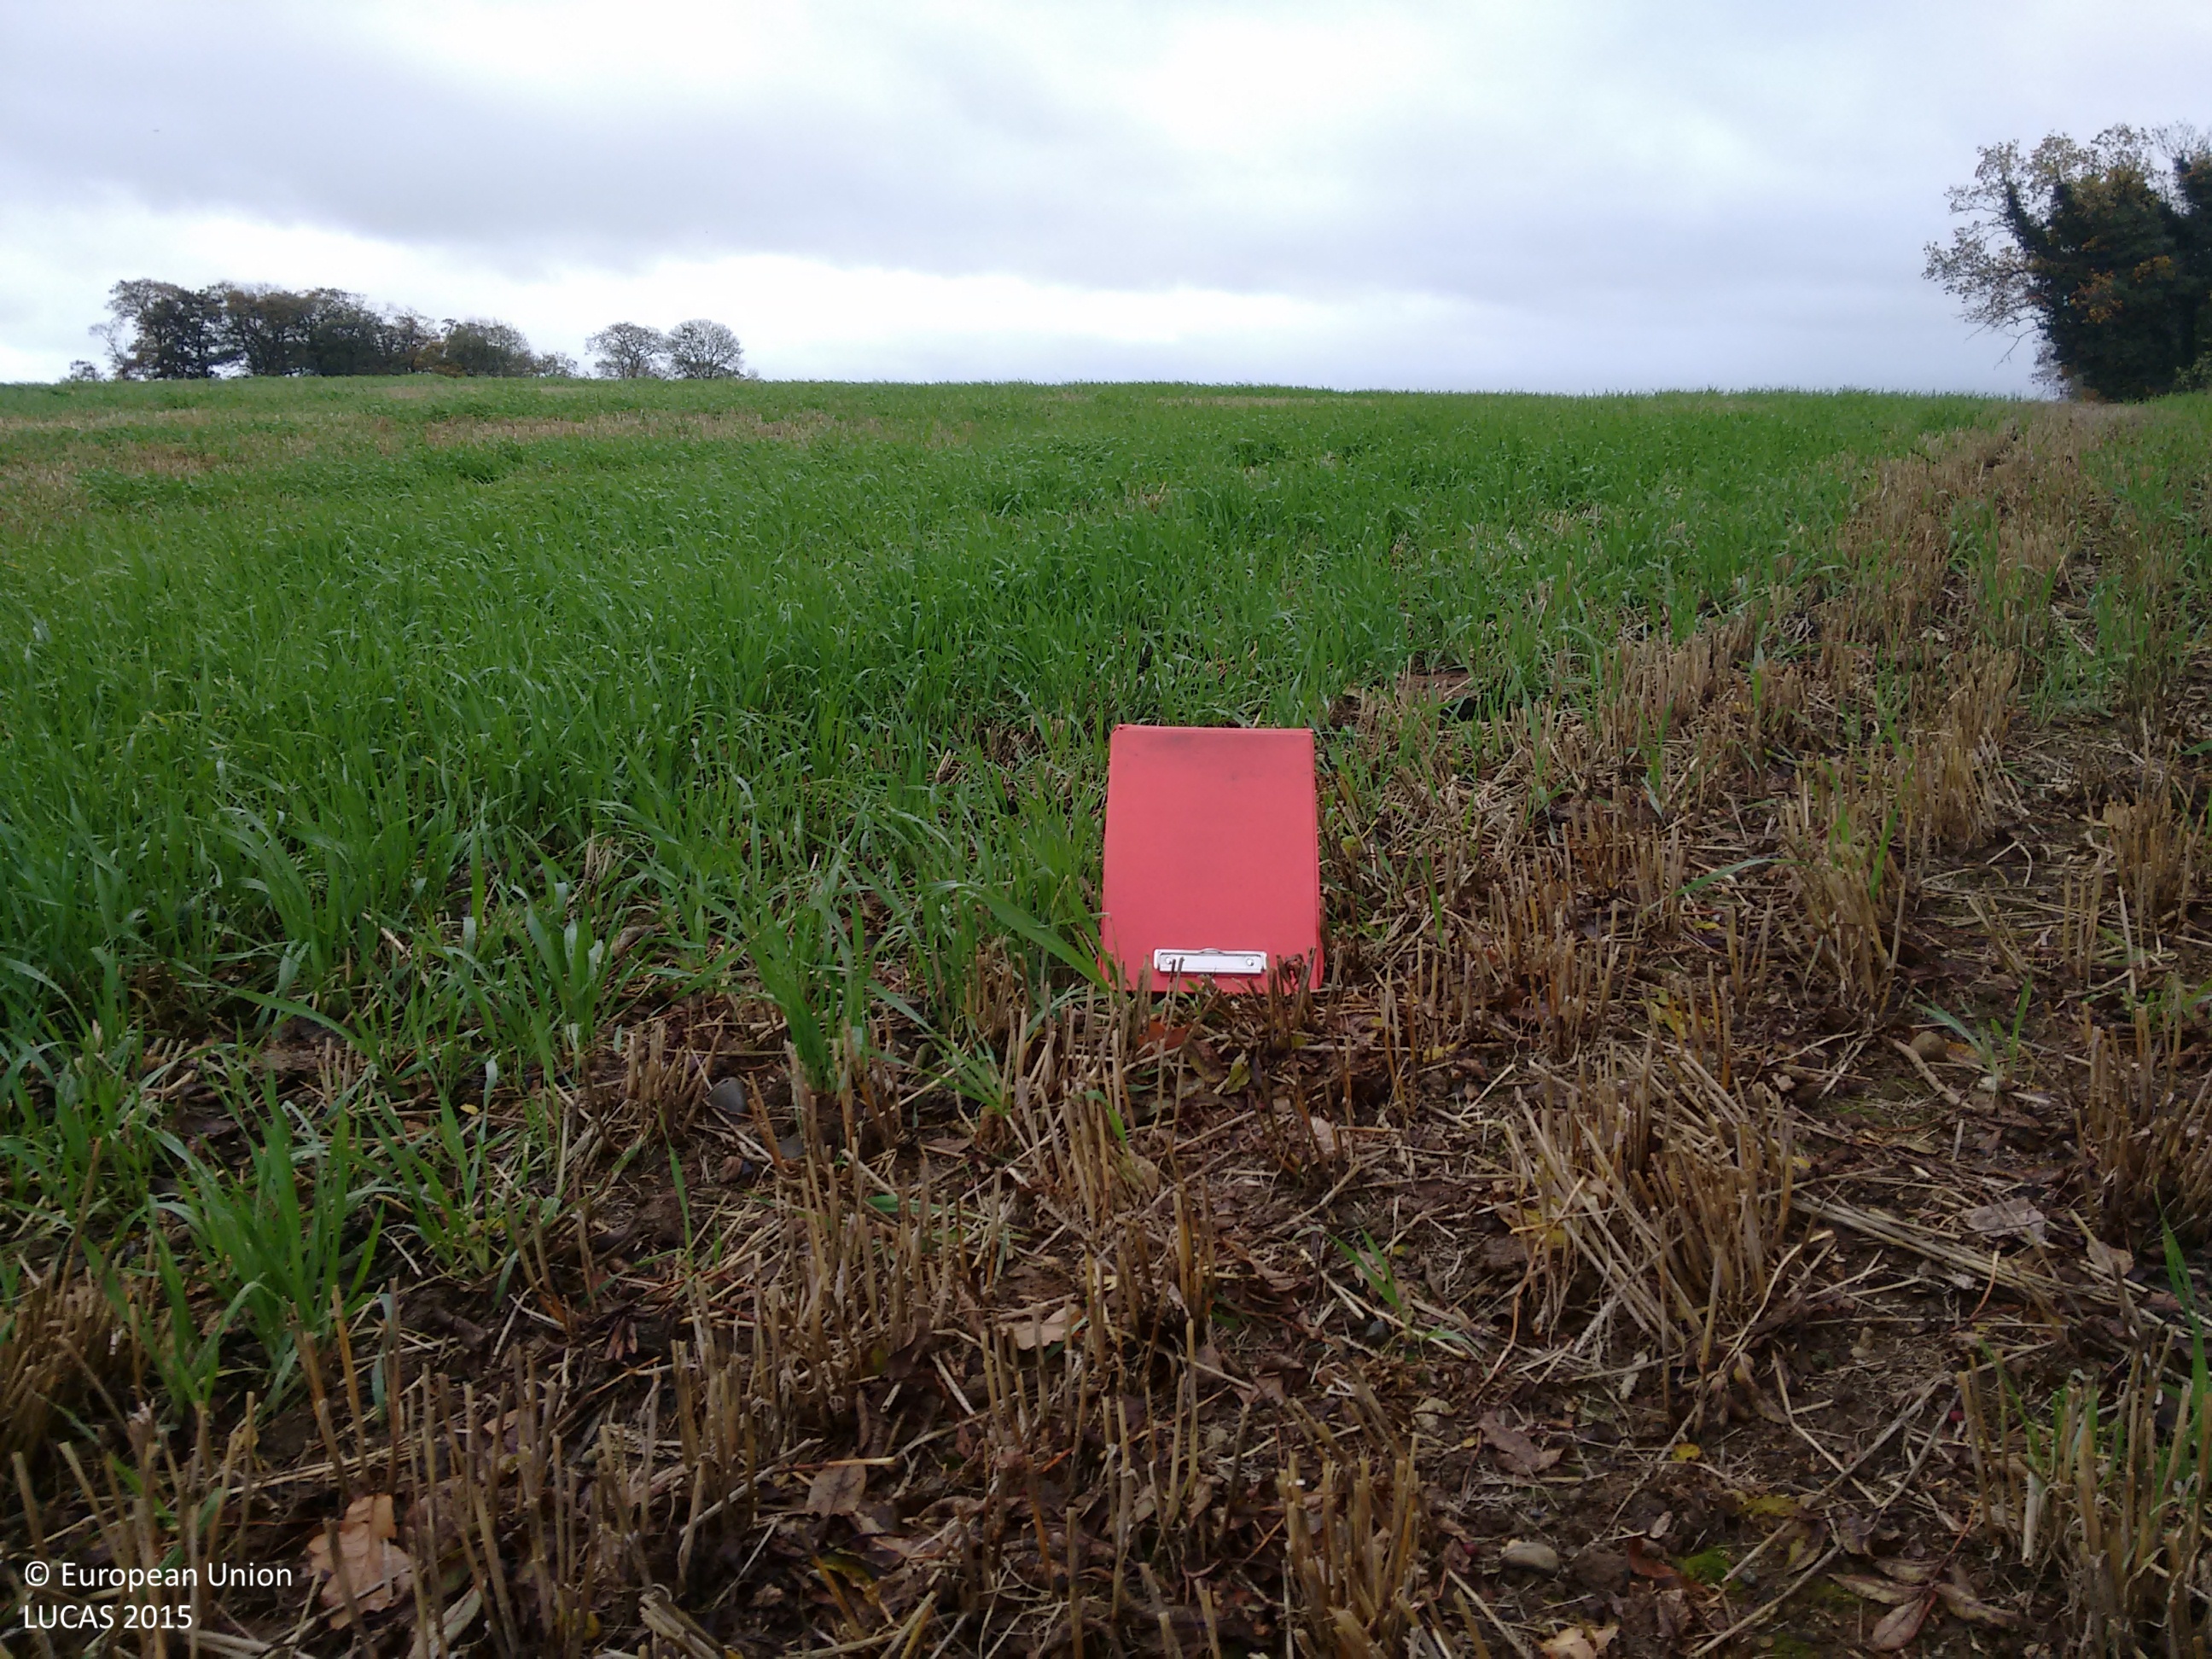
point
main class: Grassland
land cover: Grassland without tree/shrub cover
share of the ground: > 75 %
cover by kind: herbaceous plants 85 %, shrubs 5 %
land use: Agriculture (excluding fallow land and kitchen gardens)
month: November
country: IE
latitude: 53.1901
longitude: -7.6905
